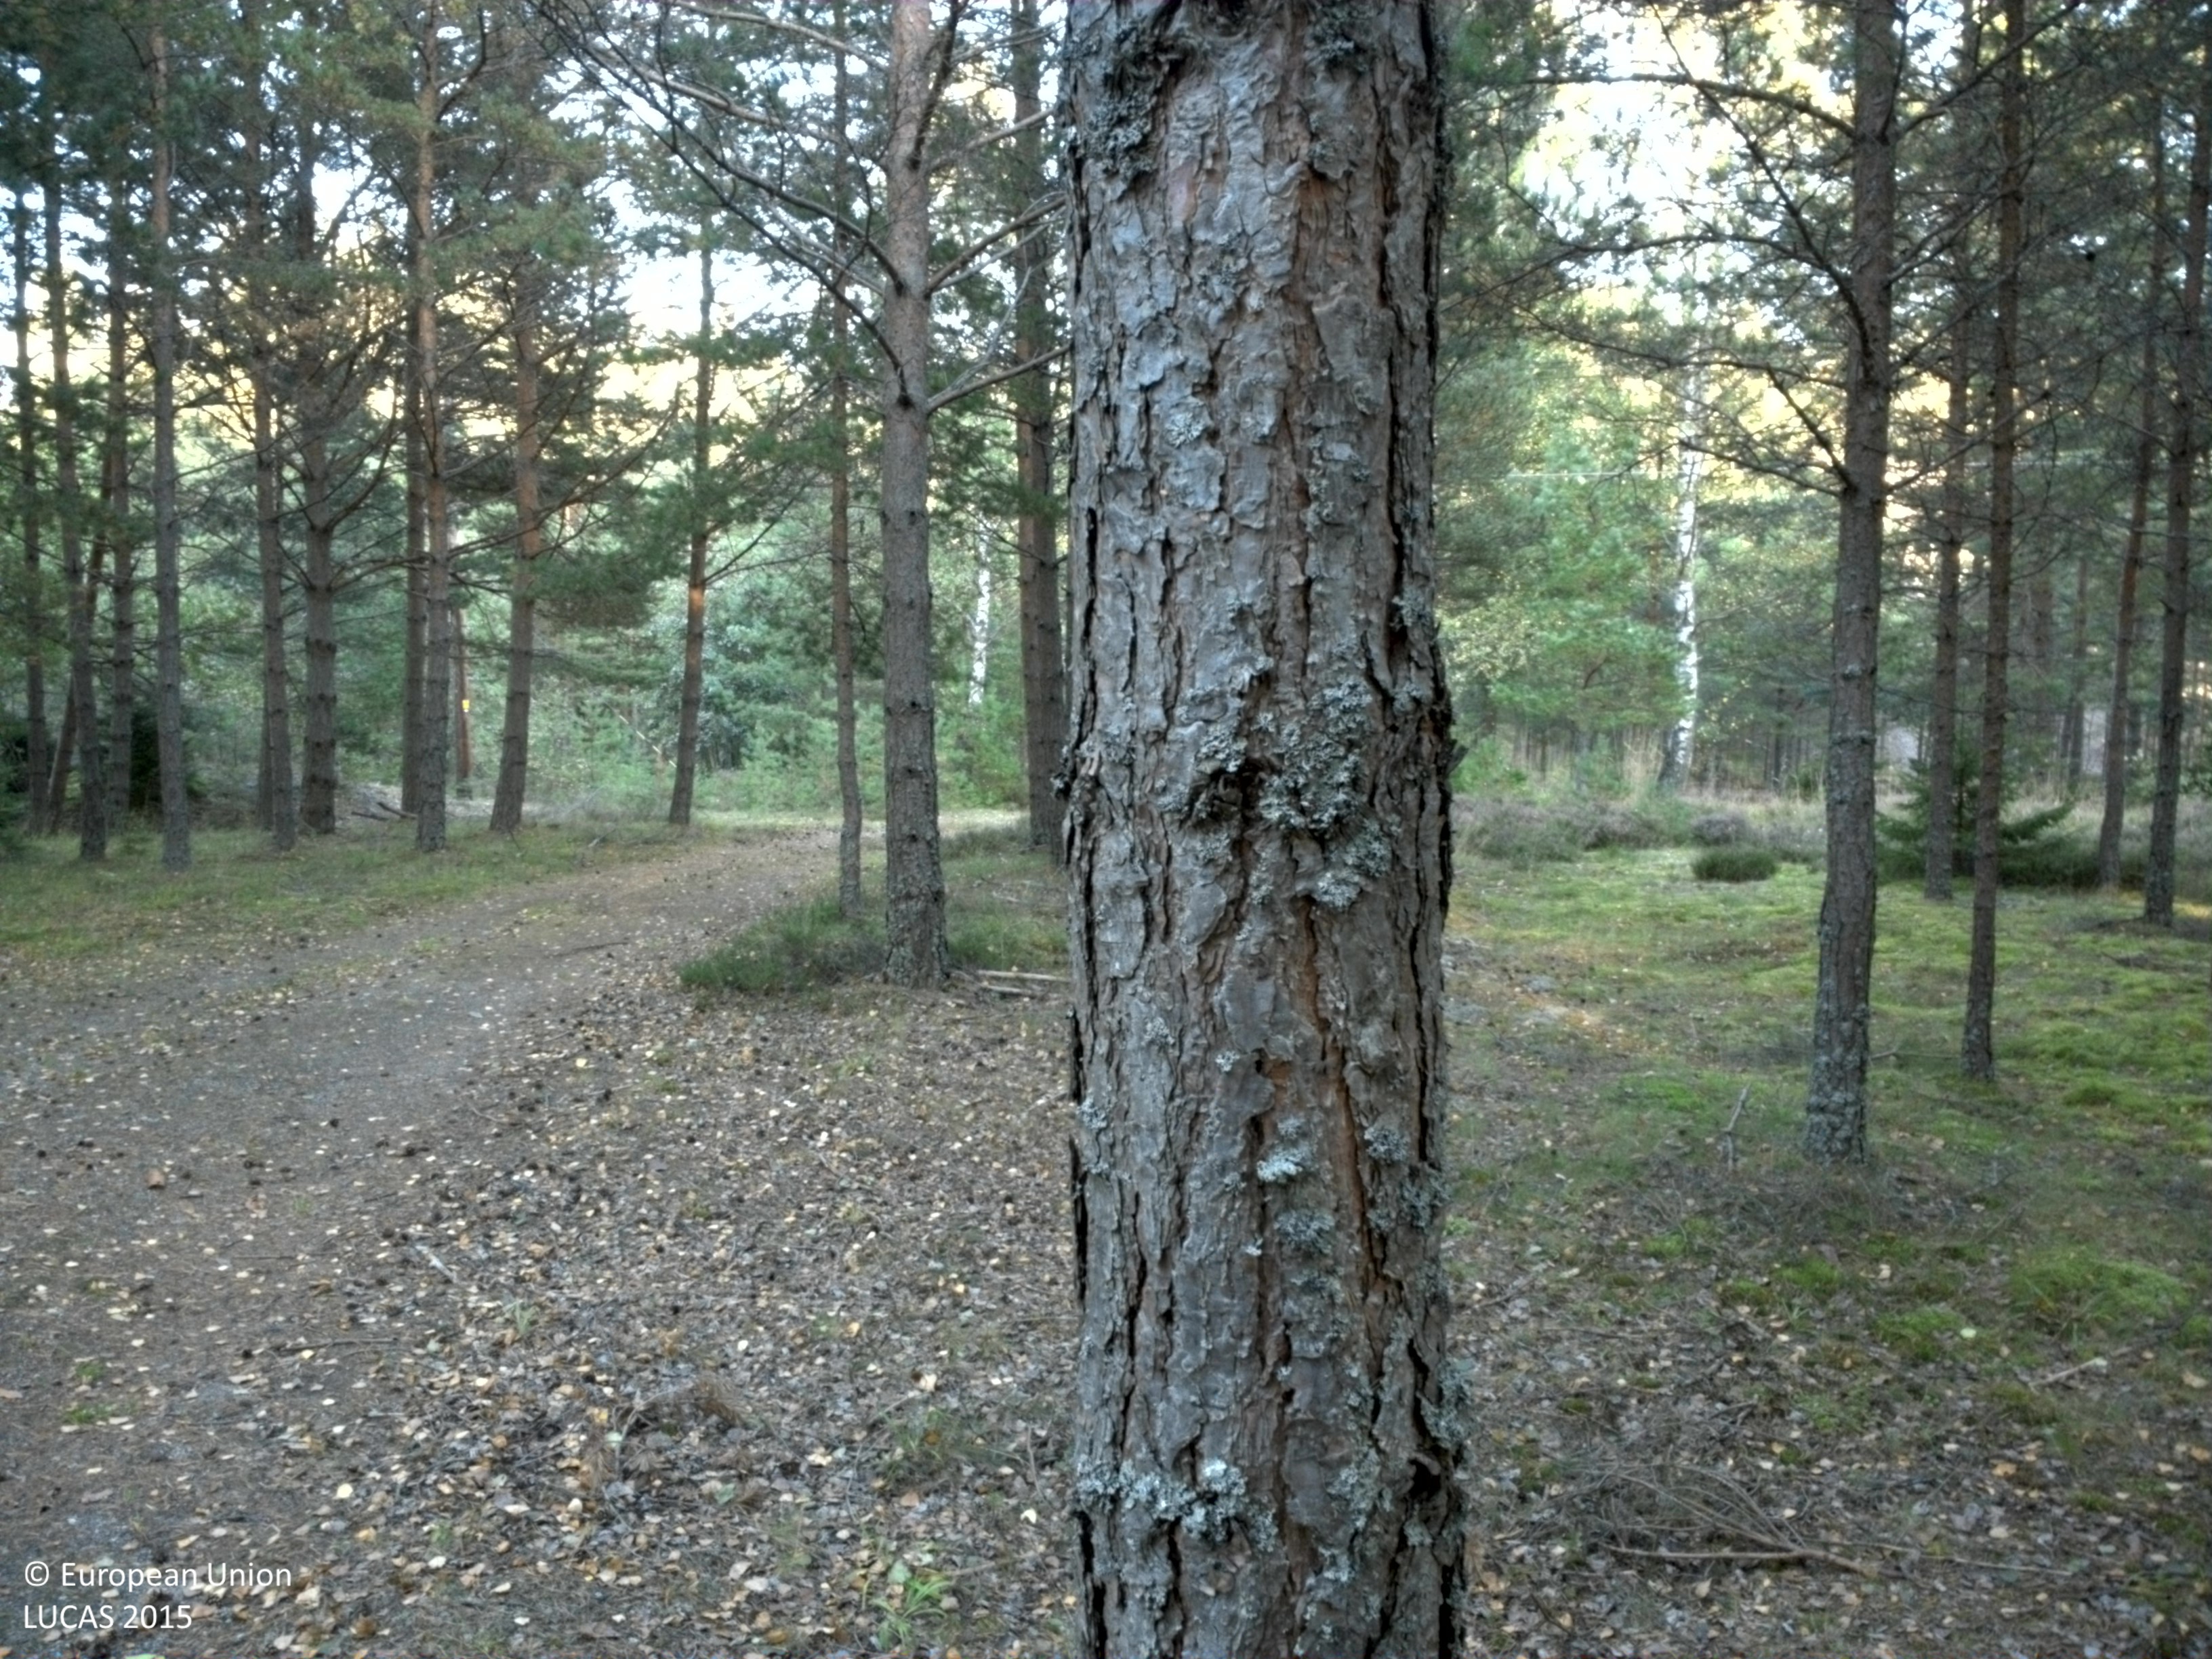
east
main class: Woodland
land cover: Pine dominated coniferous woodland
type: boreal forest
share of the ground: 50 - 75 %
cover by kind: coniferous forest trees 60 %, lichens and mosses 25 %, broadleaved forest trees 10 %, unconsolidated bare surface 5 %
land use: Amenities, museums, leisure
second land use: Sport
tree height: > 5 m
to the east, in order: Pine dominated coniferous woodland; Electric lines; Pine dominated coniferous woodland; Paved roads, cycling and walking lanes; Pine dominated coniferous woodland; Paved roads, cycling and walking lanes; Pine dominated coniferous woodland; Dry stone walls; Pine dominated coniferous woodland; Shruby margins; Paved roads, cycling and walking lanes; Spruce dominated coniferous woodland
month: September
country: SE
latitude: 59.2959
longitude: 18.6937
